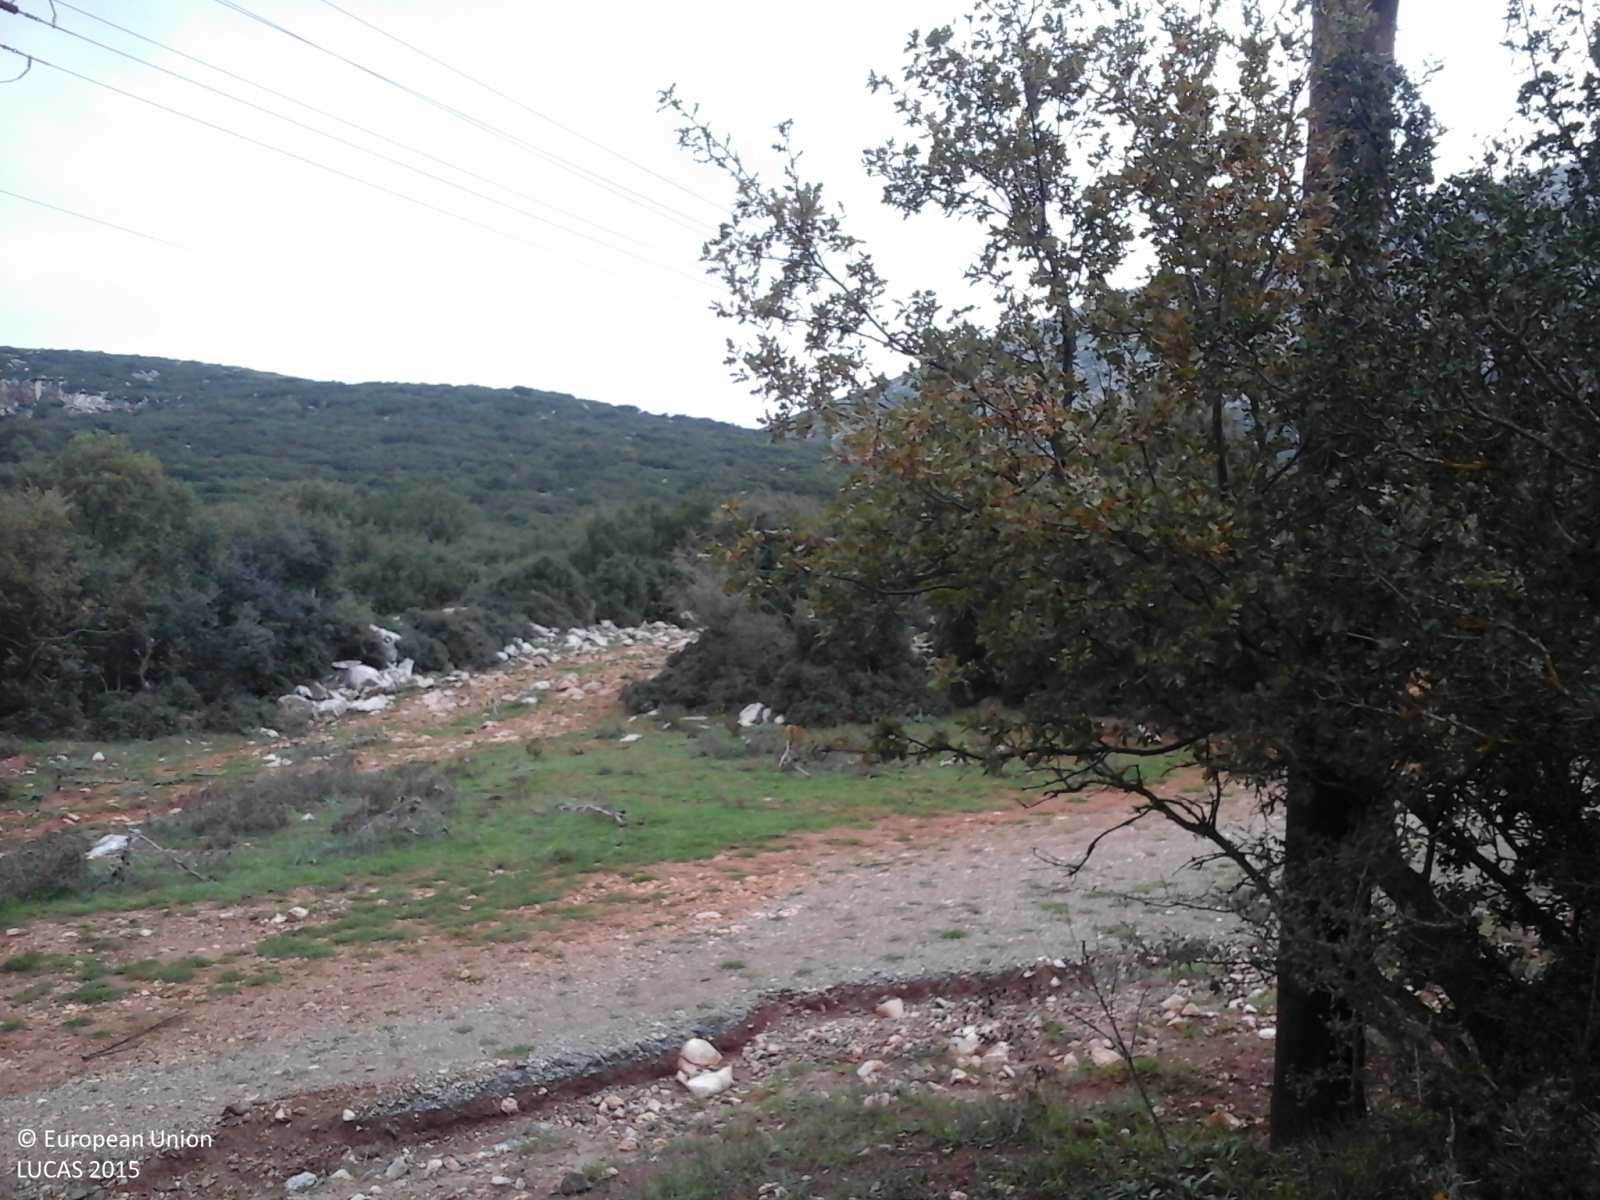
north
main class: Woodland
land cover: Broadleaved woodland
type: thermophilous deciduous forest
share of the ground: 25 - 50 %
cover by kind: broadleaved forest trees 50 %, shrubs 45 %, unconsolidated bare surface 5 %
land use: Semi-natural and natural areas not in use
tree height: > 5 m
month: October
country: GR
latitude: 38.3294
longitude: 22.9154
